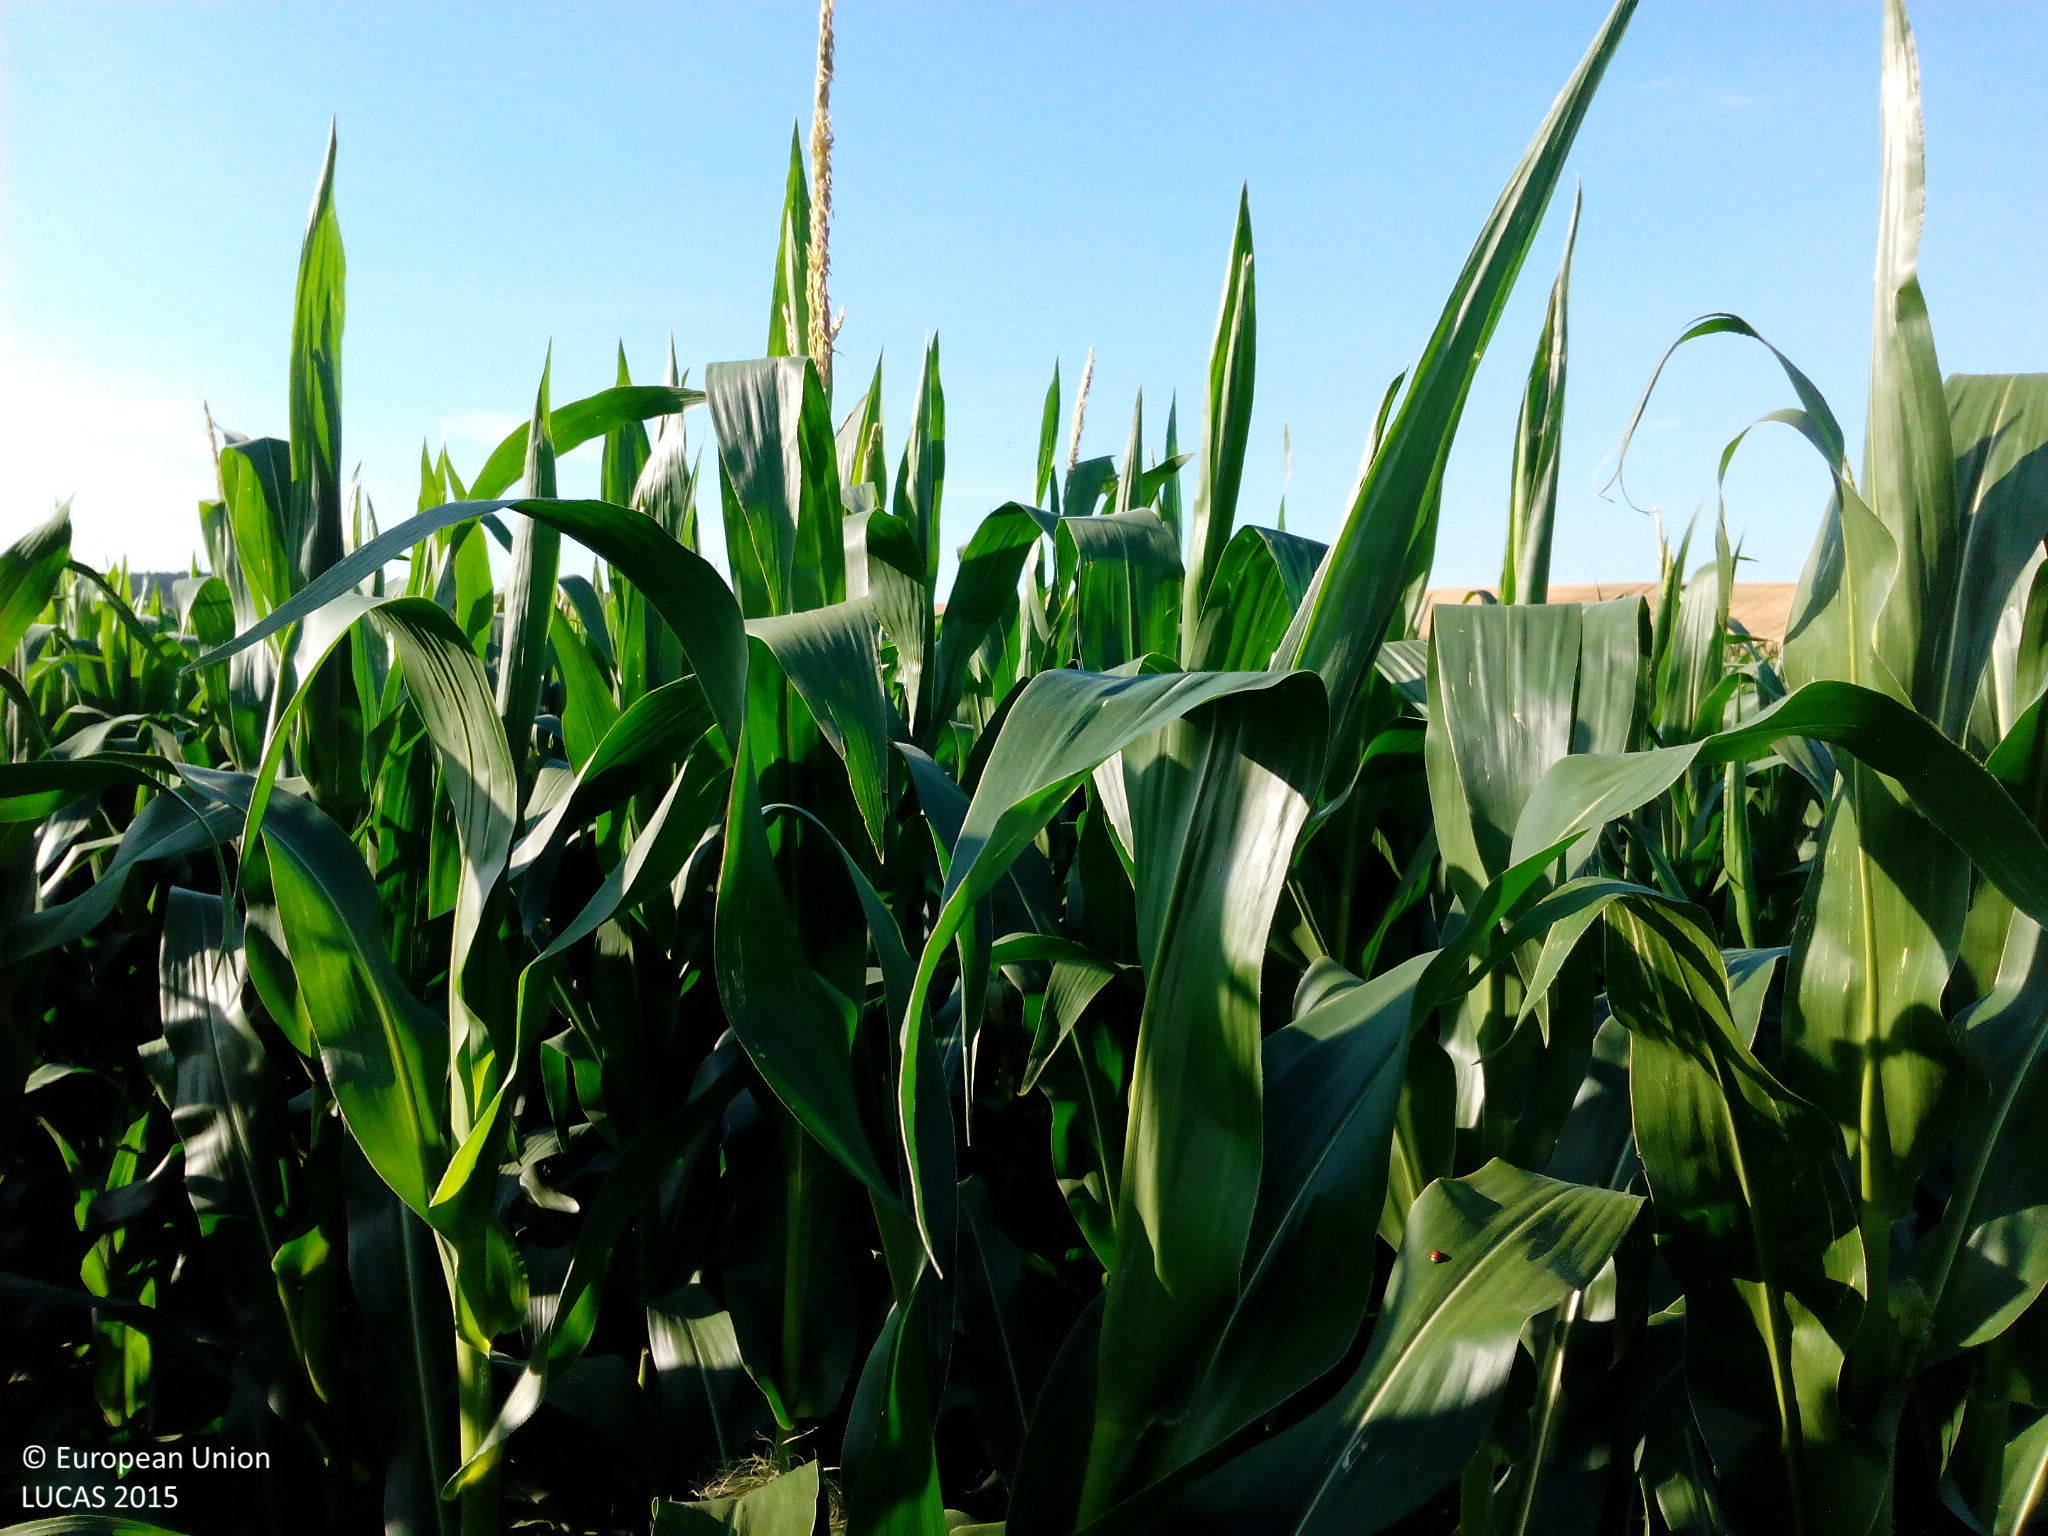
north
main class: Cropland
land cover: Maize
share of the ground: > 75 %
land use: Agriculture (excluding fallow land and kitchen gardens)
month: August
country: DE
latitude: 53.5623
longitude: 13.6686
